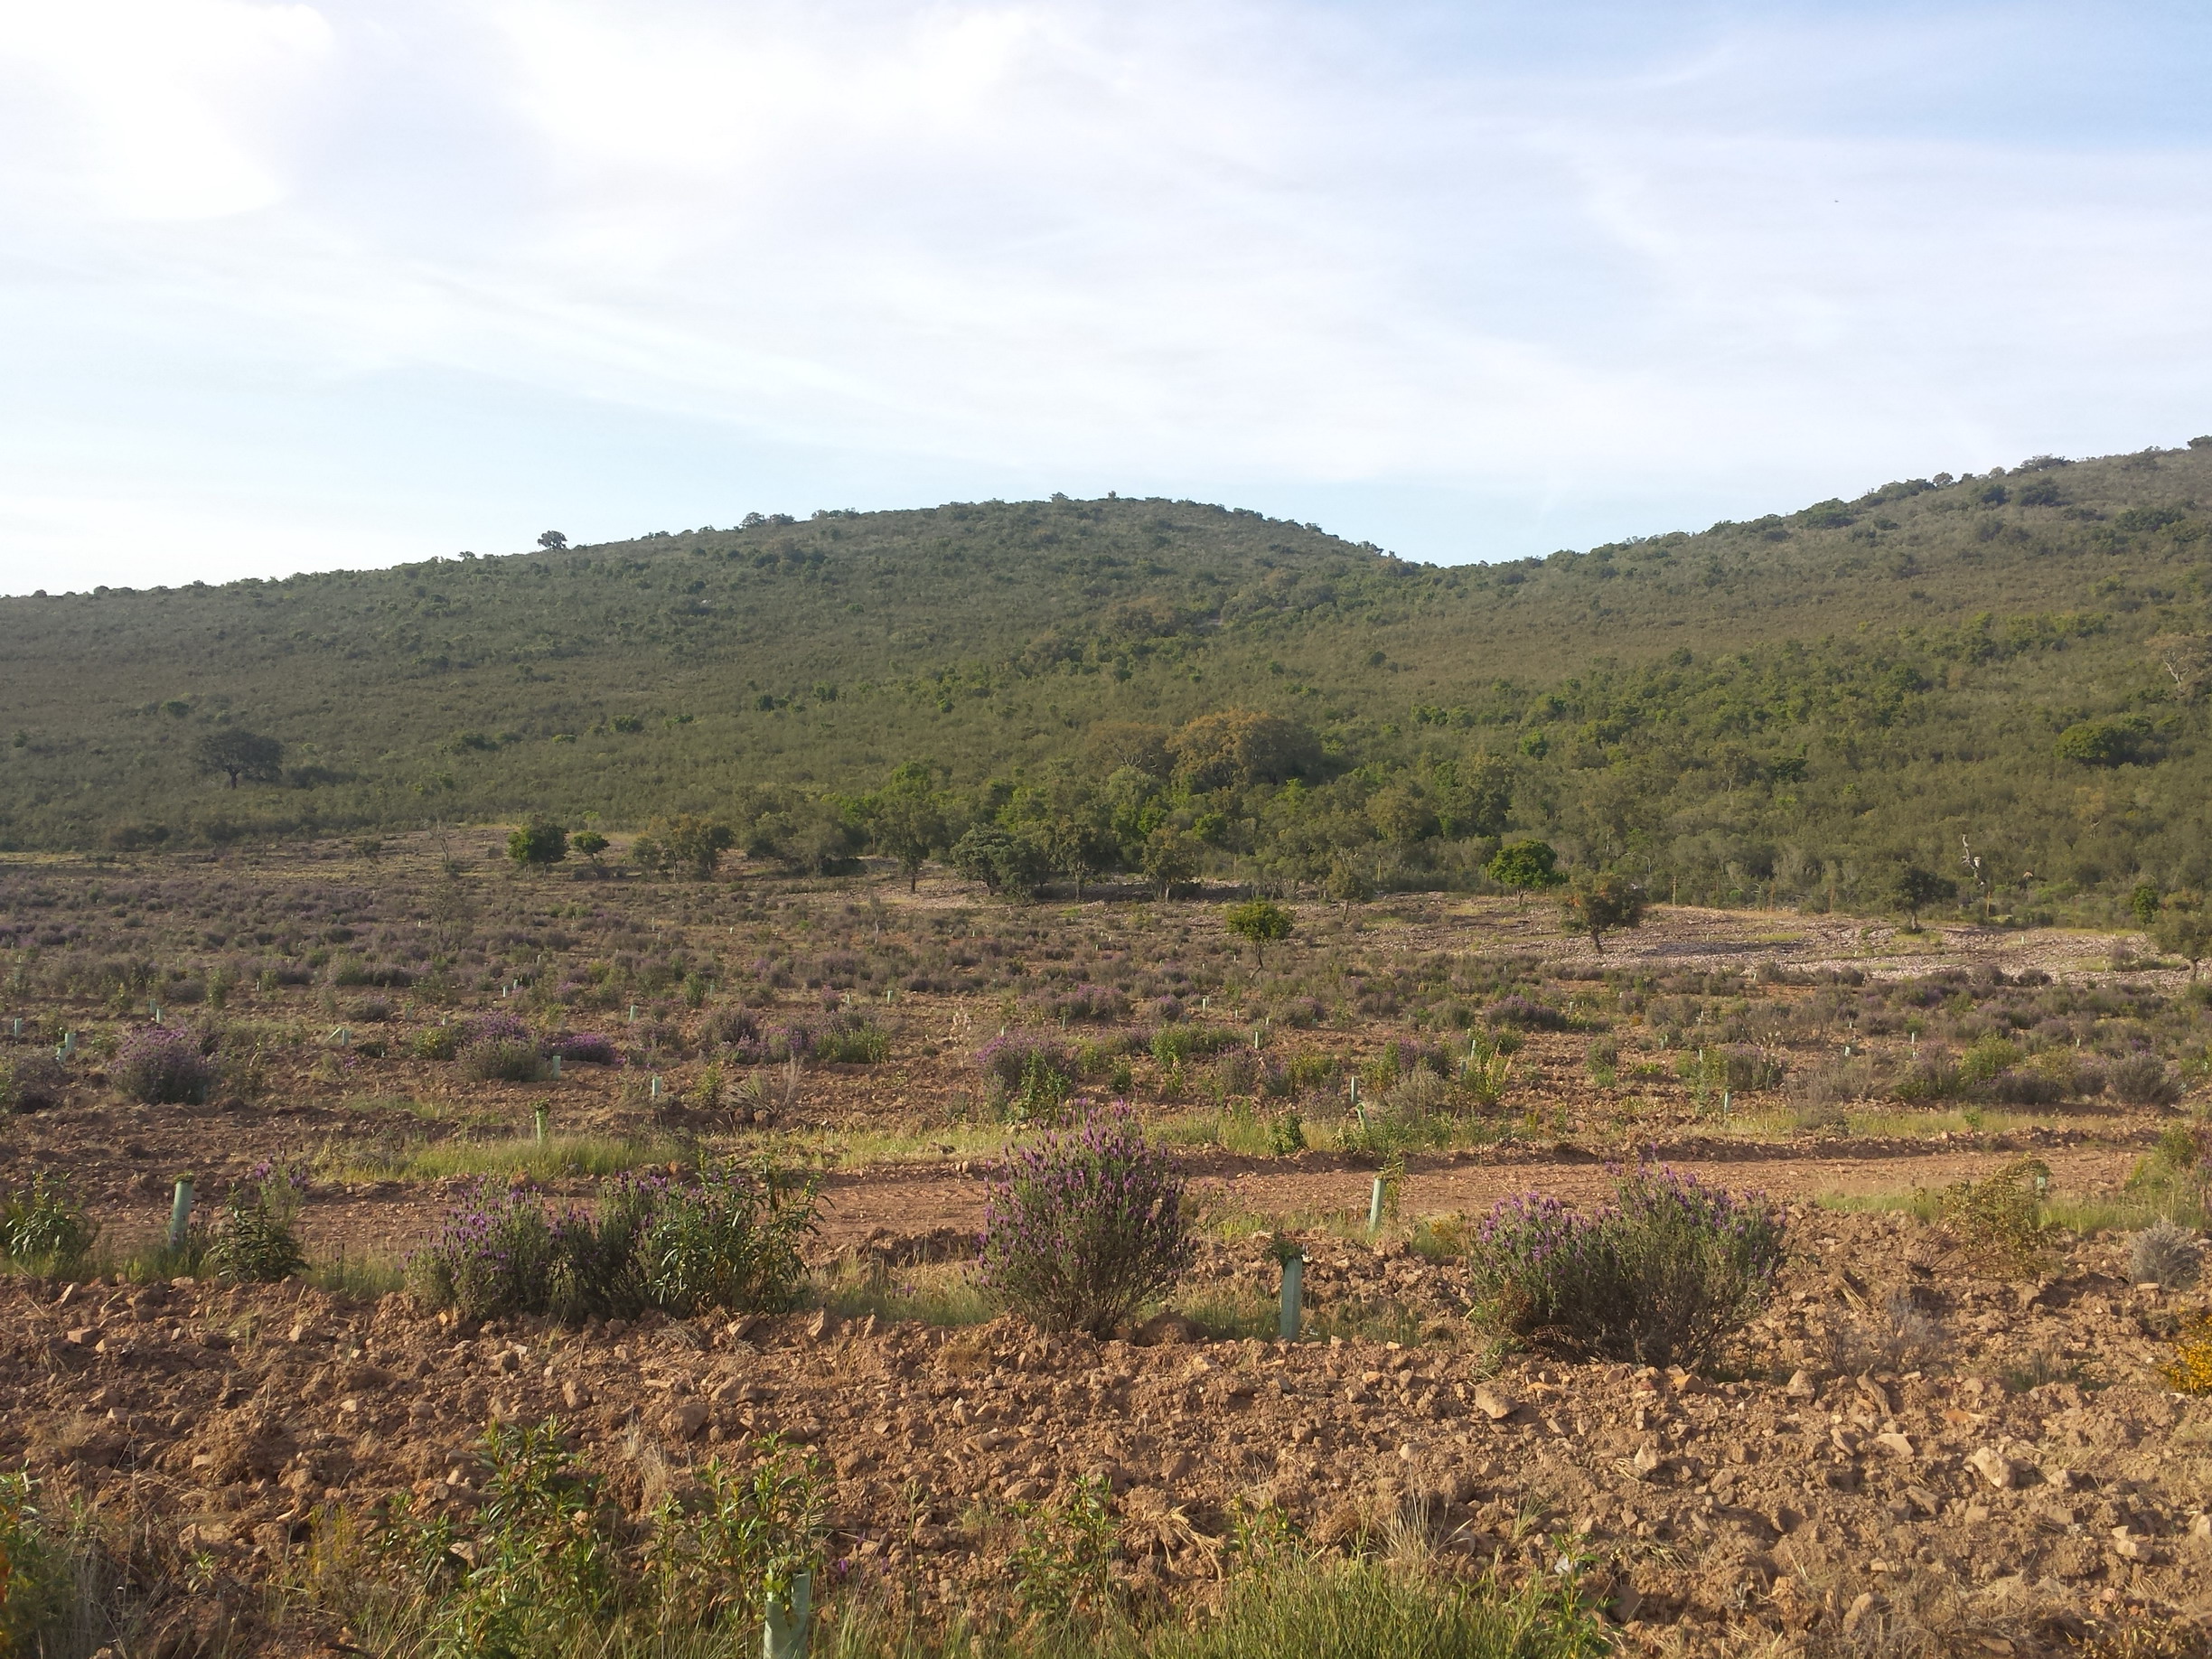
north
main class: Shrubland
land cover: Shrubland without tree cover
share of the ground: 10 - 25 %
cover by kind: unconsolidated bare surface 70 %, shrubs 15 %, herbaceous plants 15 %
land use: Forestry
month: May
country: ES
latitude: 39.5856
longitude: -7.1915
